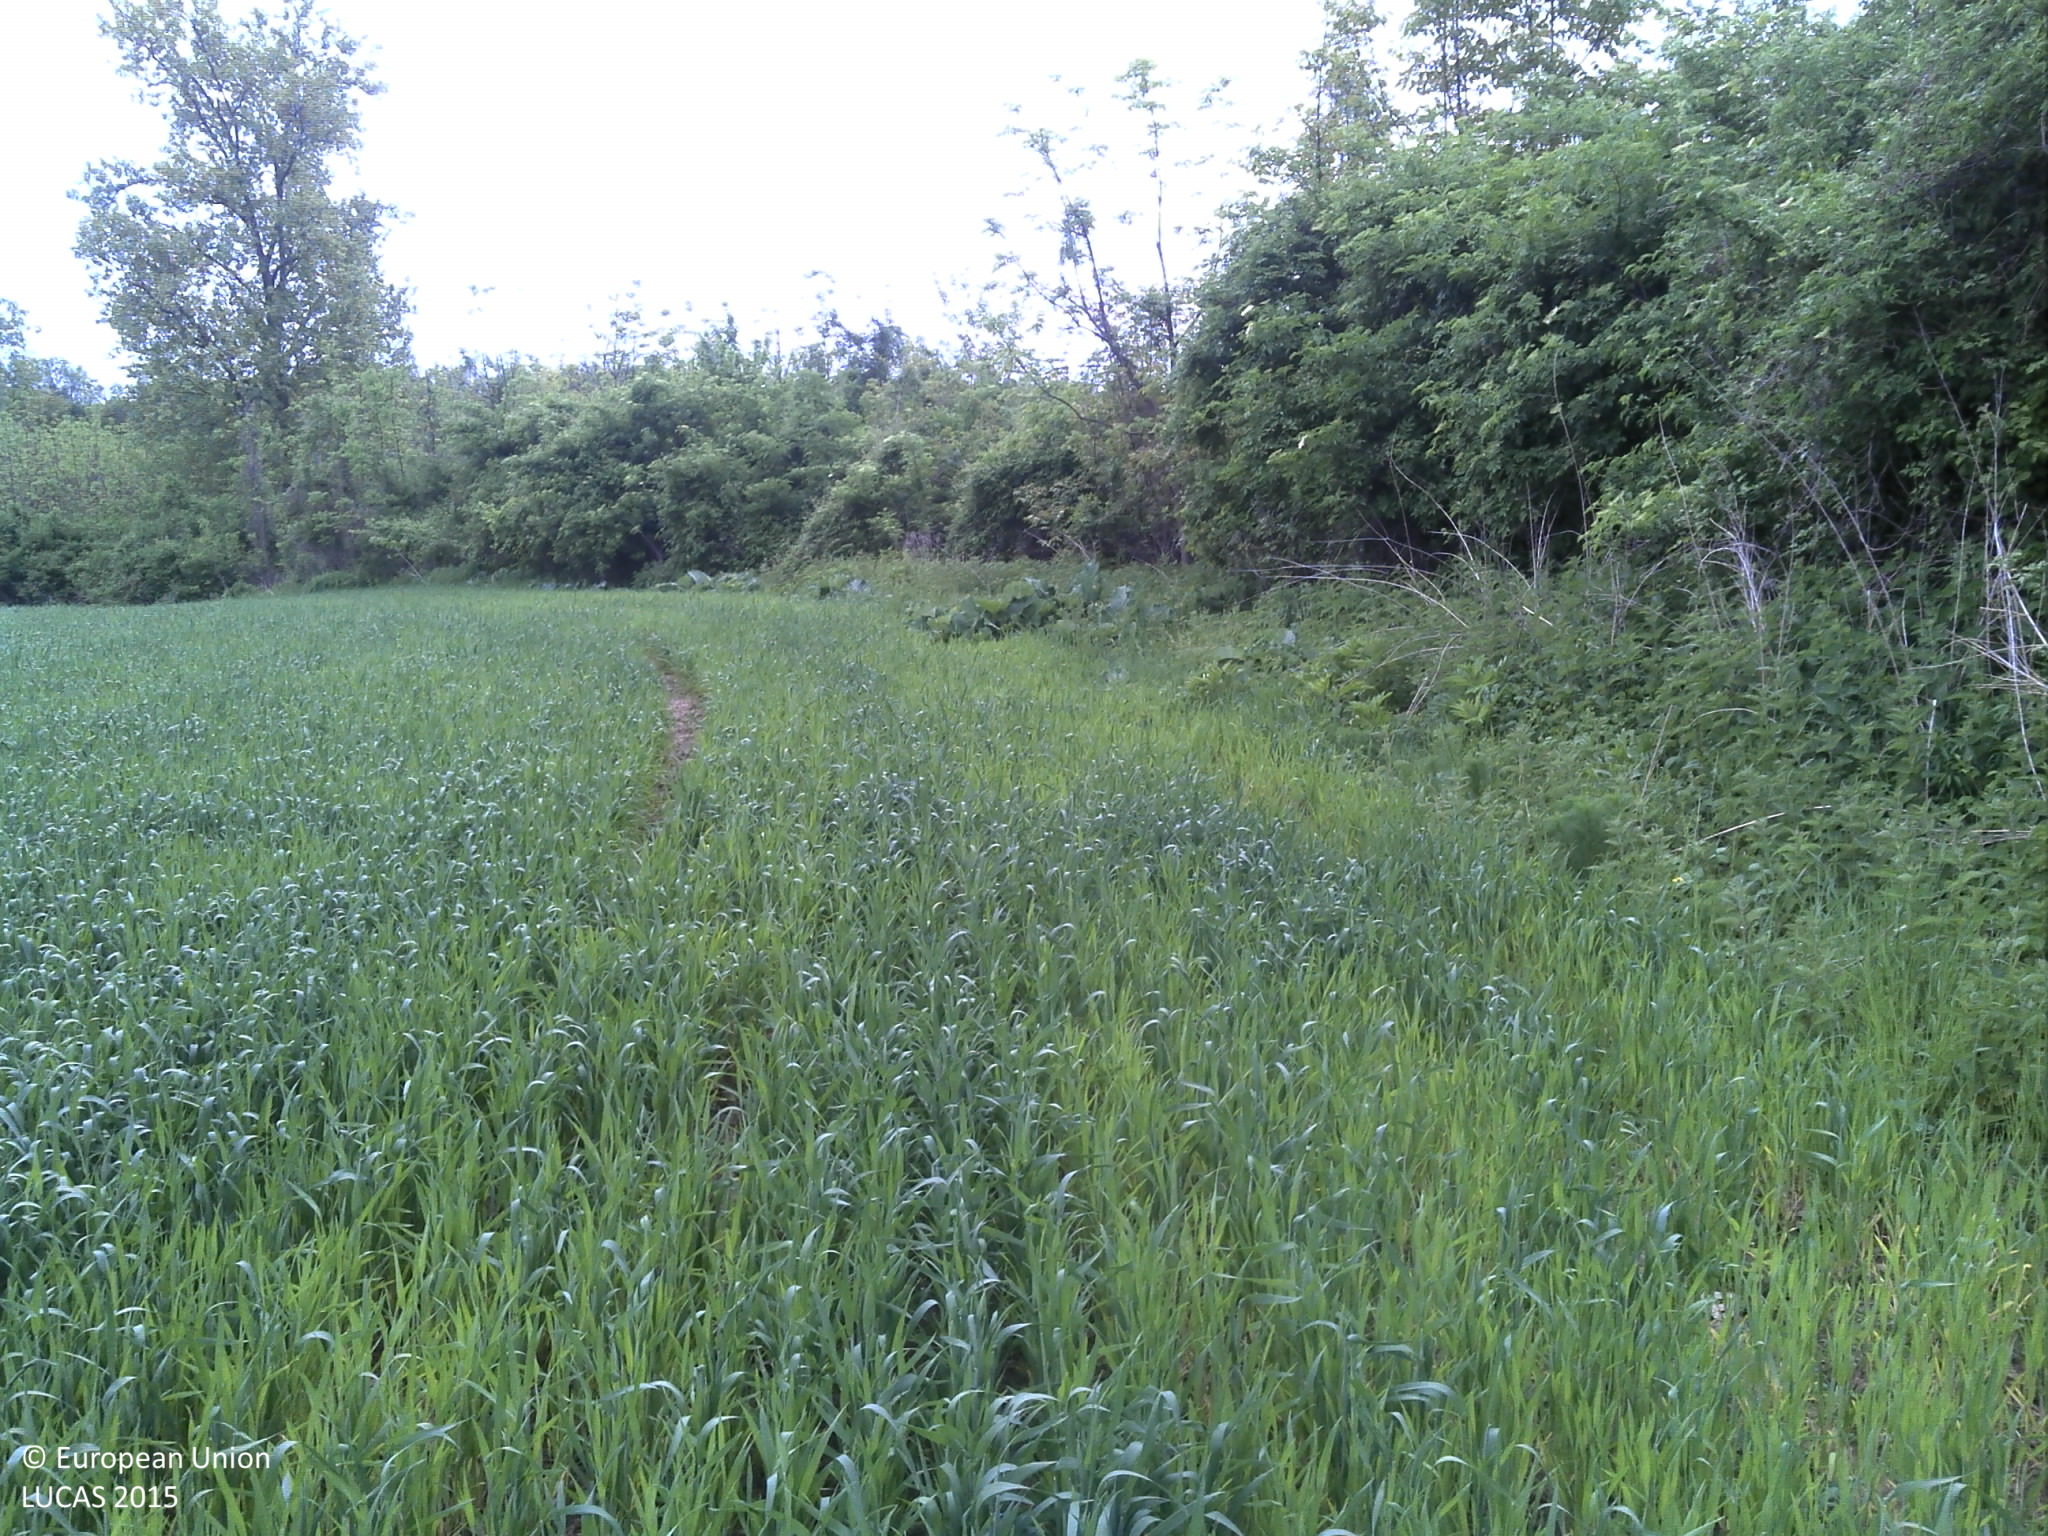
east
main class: Cropland
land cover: Common wheat
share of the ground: > 75 %
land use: Agriculture (excluding fallow land and kitchen gardens)
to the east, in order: Common wheat
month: May
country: HR
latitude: 45.2340
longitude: 19.1422
